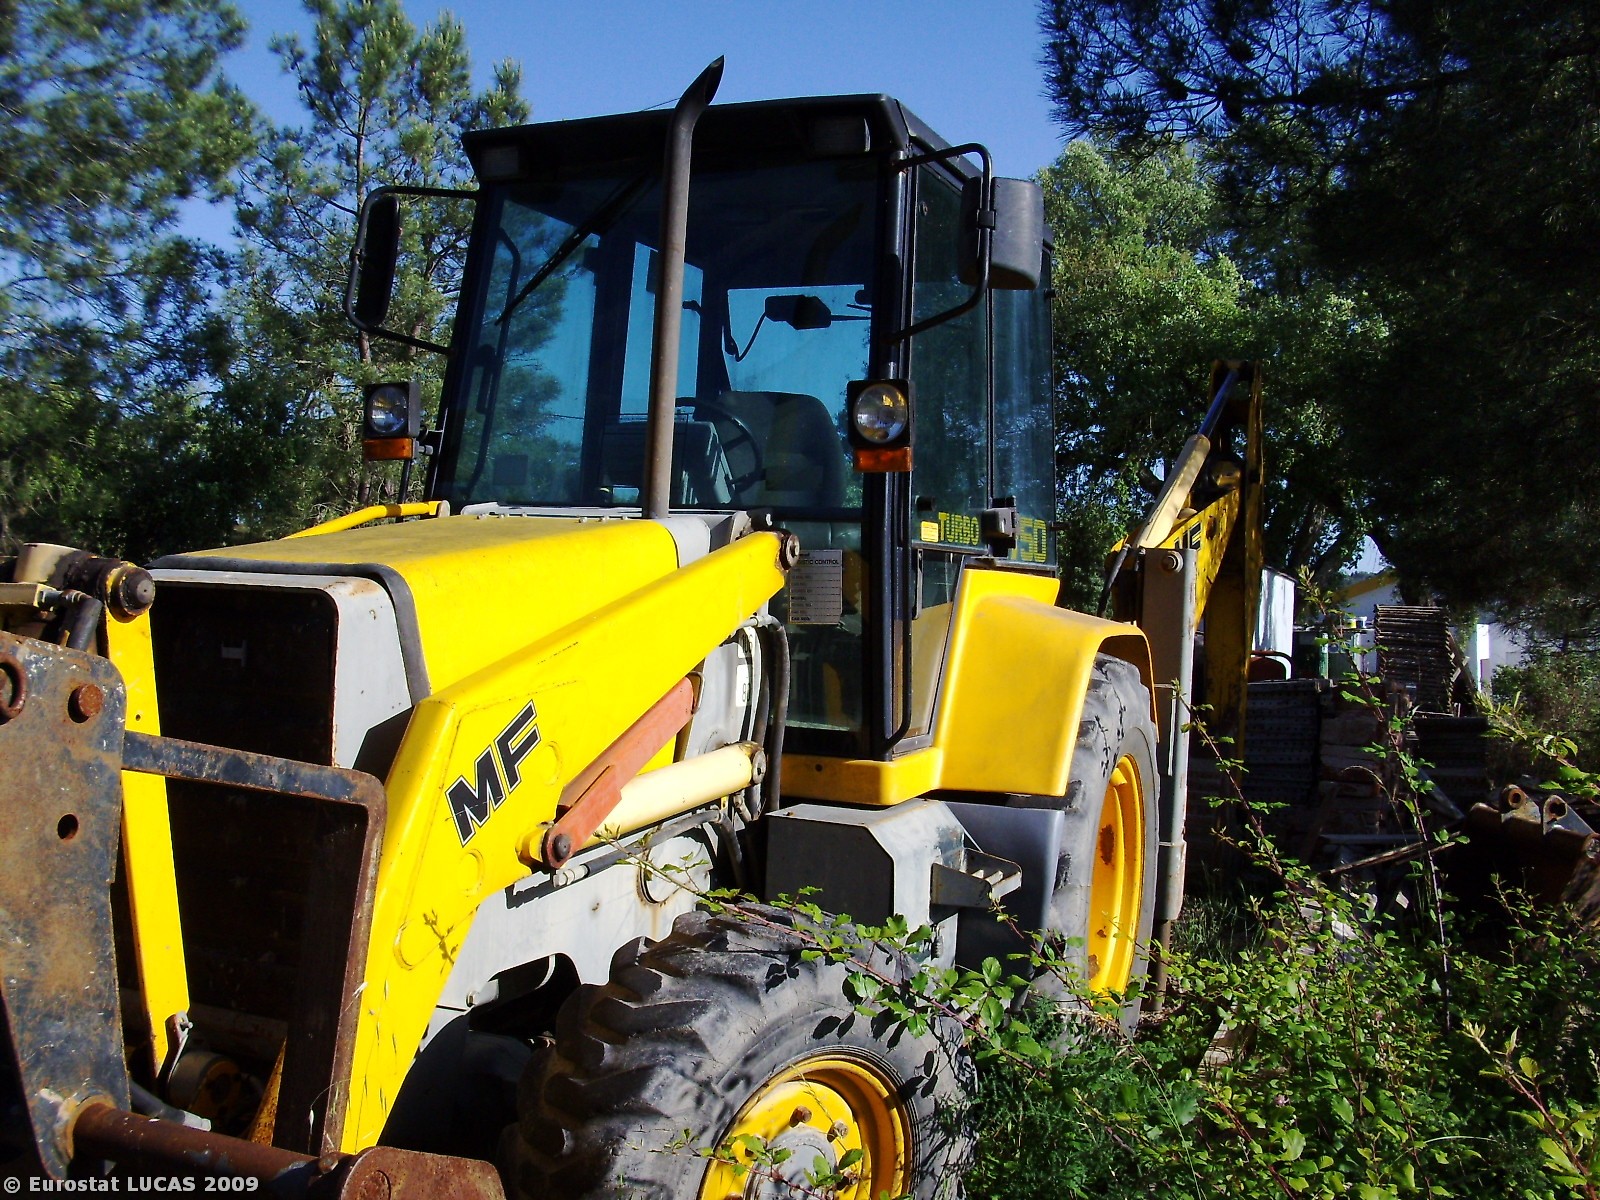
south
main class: Woodland
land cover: Mixed woodland
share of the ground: 25 - 50 %
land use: Forestry
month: May
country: PT
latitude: 39.2516
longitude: -8.0043
